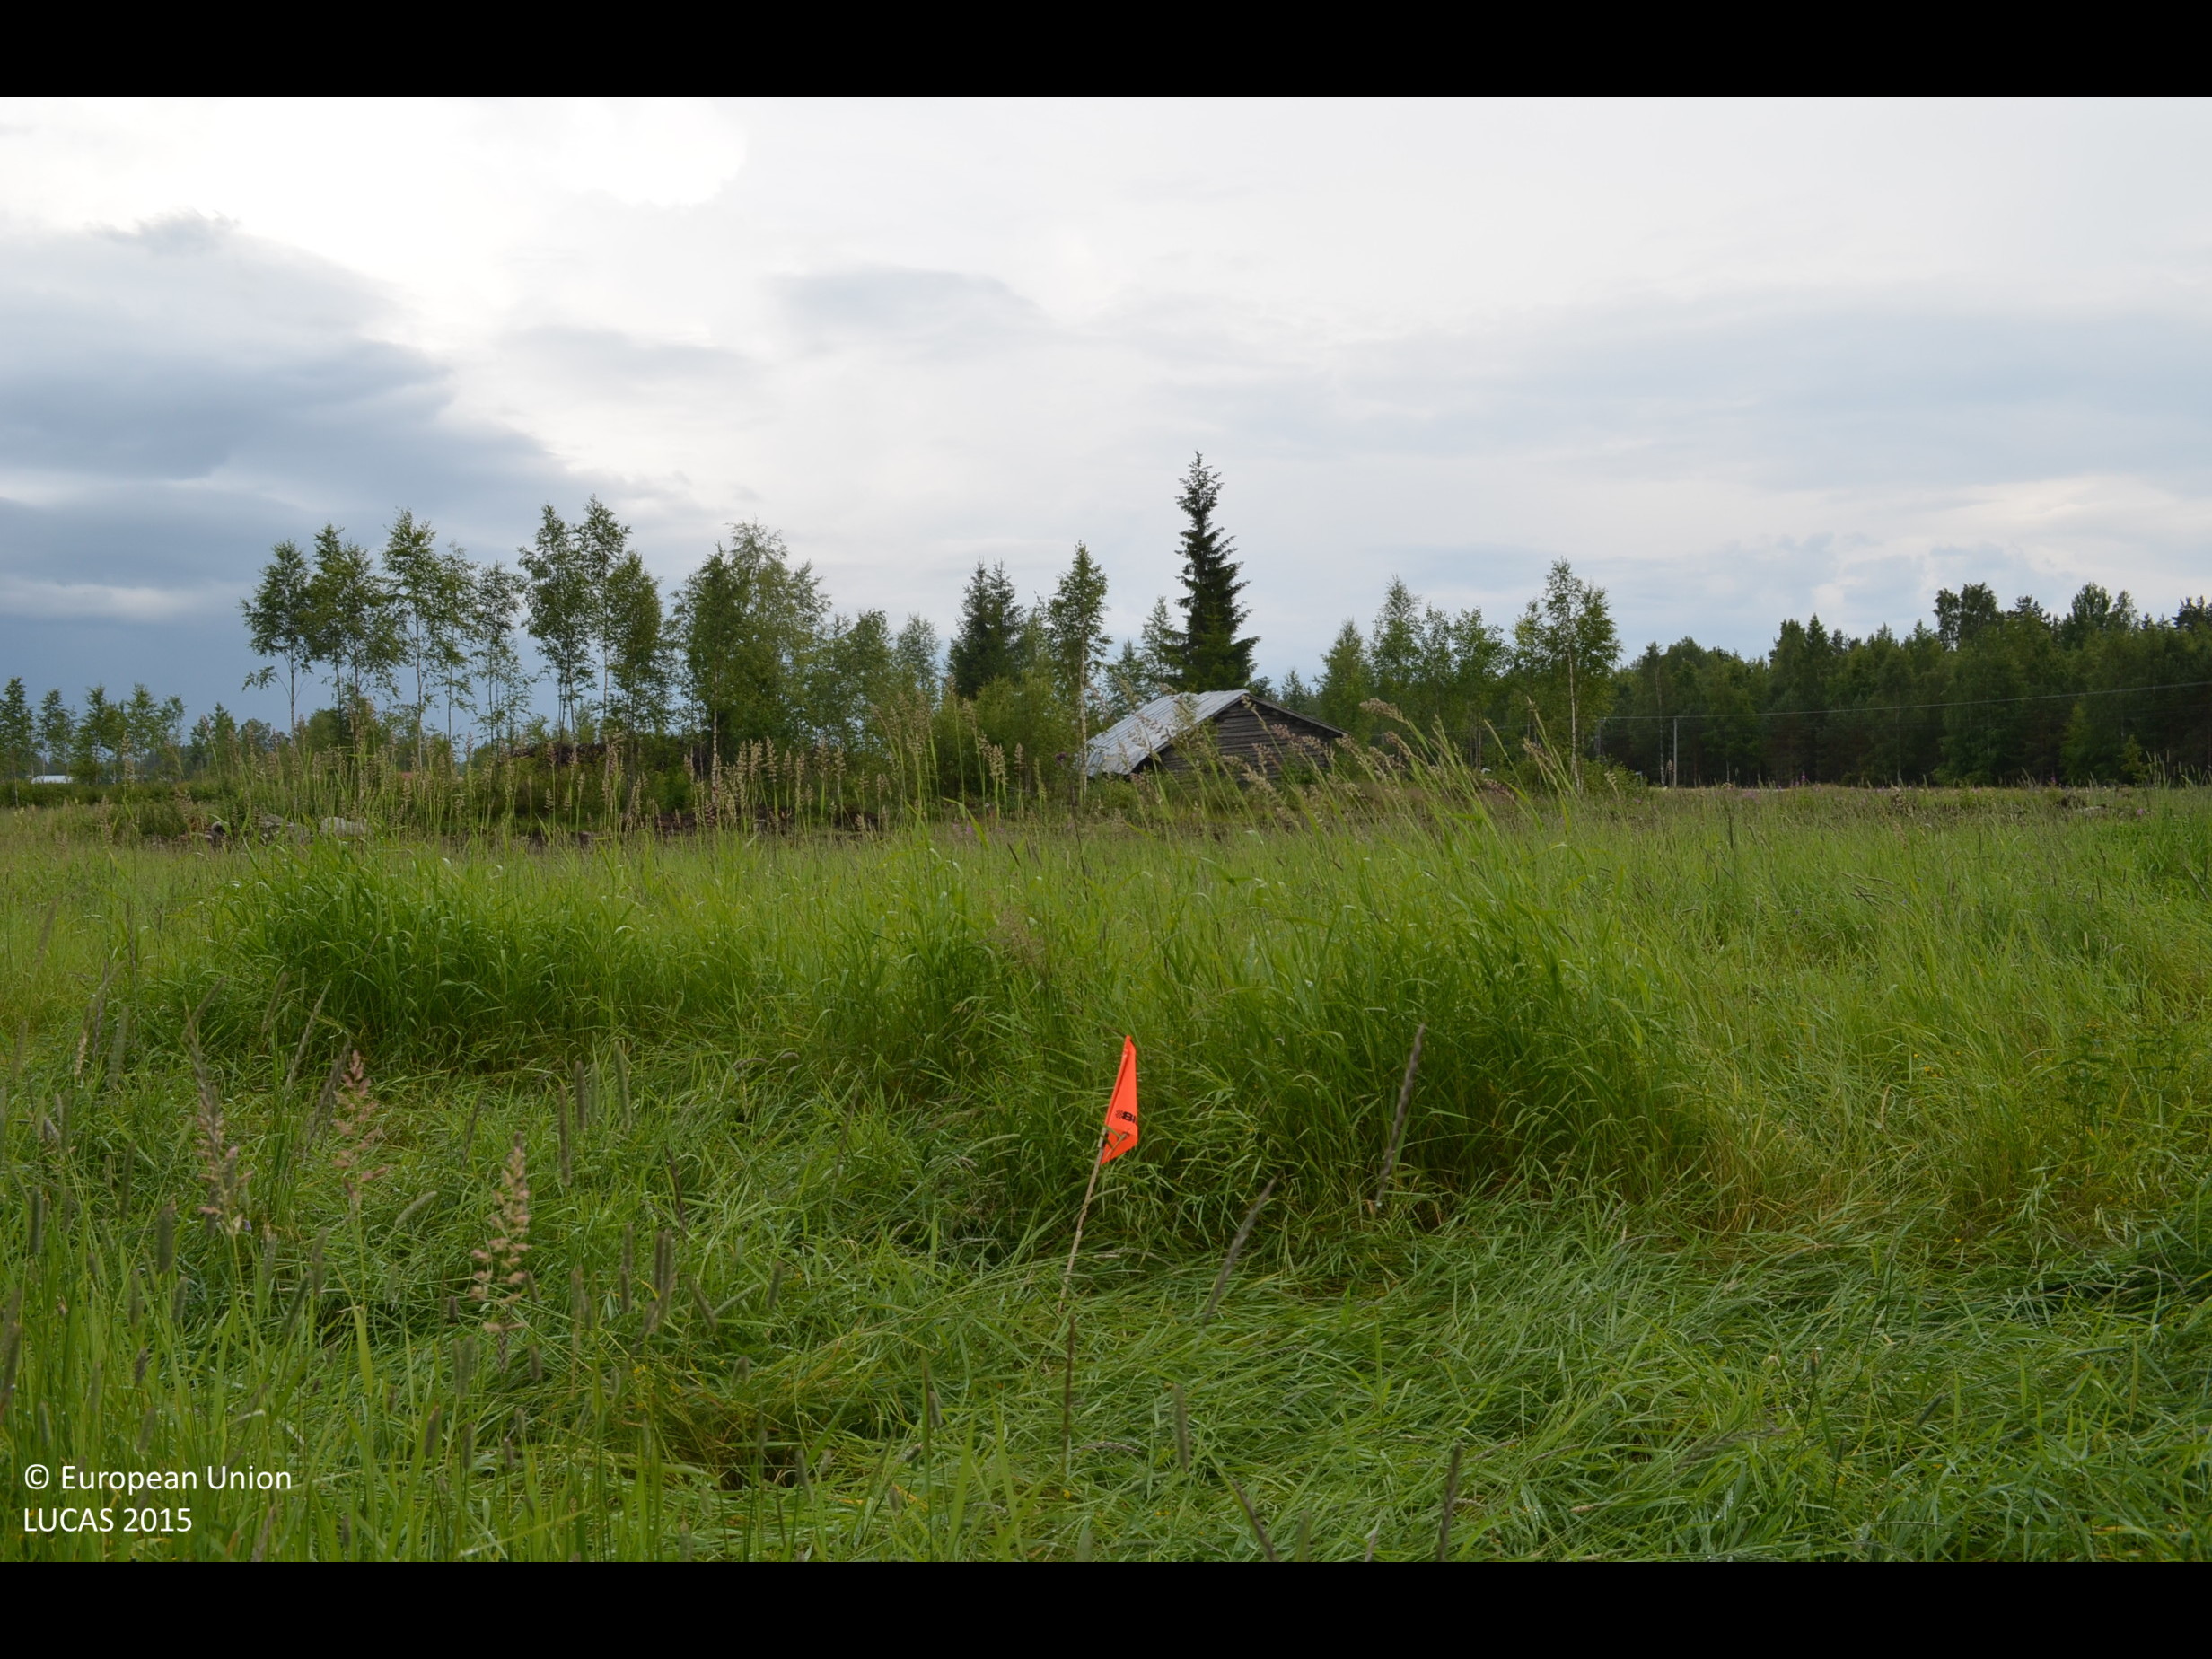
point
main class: Cropland
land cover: Temporary grasslands
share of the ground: > 75 %
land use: Agriculture (excluding fallow land and kitchen gardens)
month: July
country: FI
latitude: 62.2893
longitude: 23.3521
